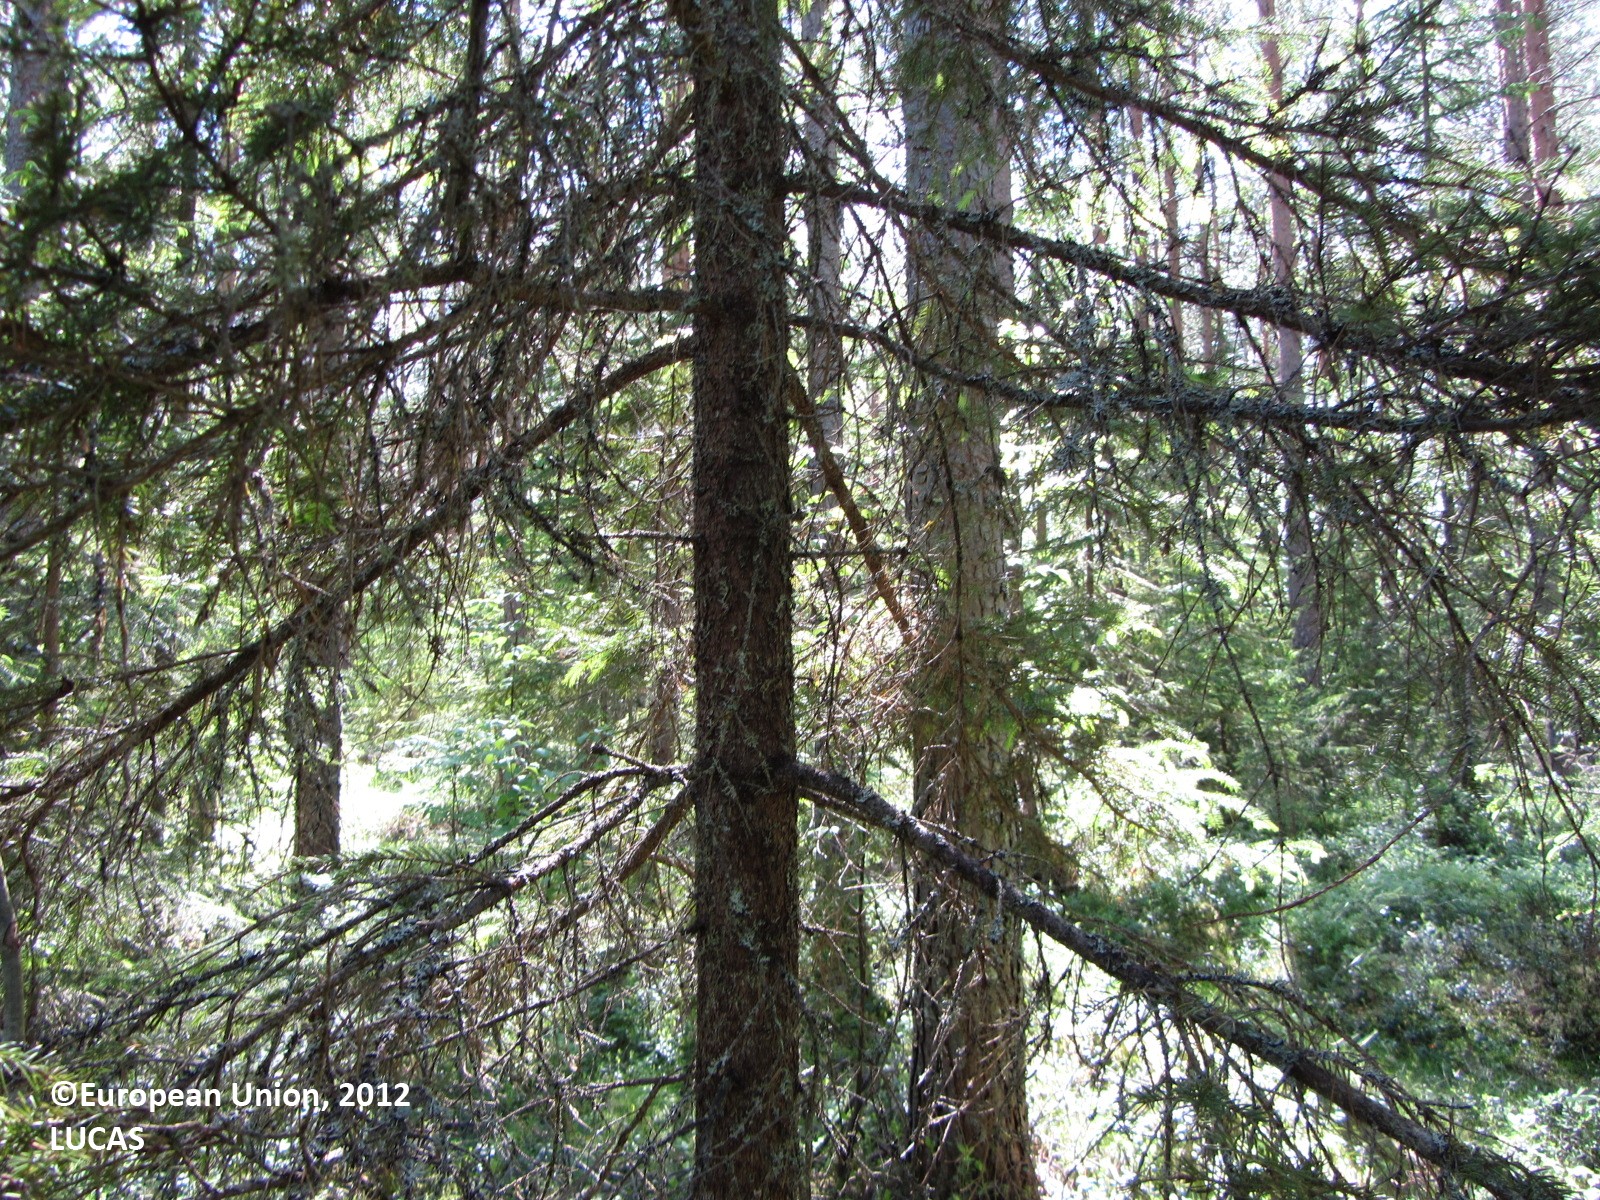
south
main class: Woodland
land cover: Spruce dominated coniferous woodland
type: boreal forest
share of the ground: > 75 %
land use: Forestry
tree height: > 5 m
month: June
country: FI
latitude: 62.1832
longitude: 25.0295
